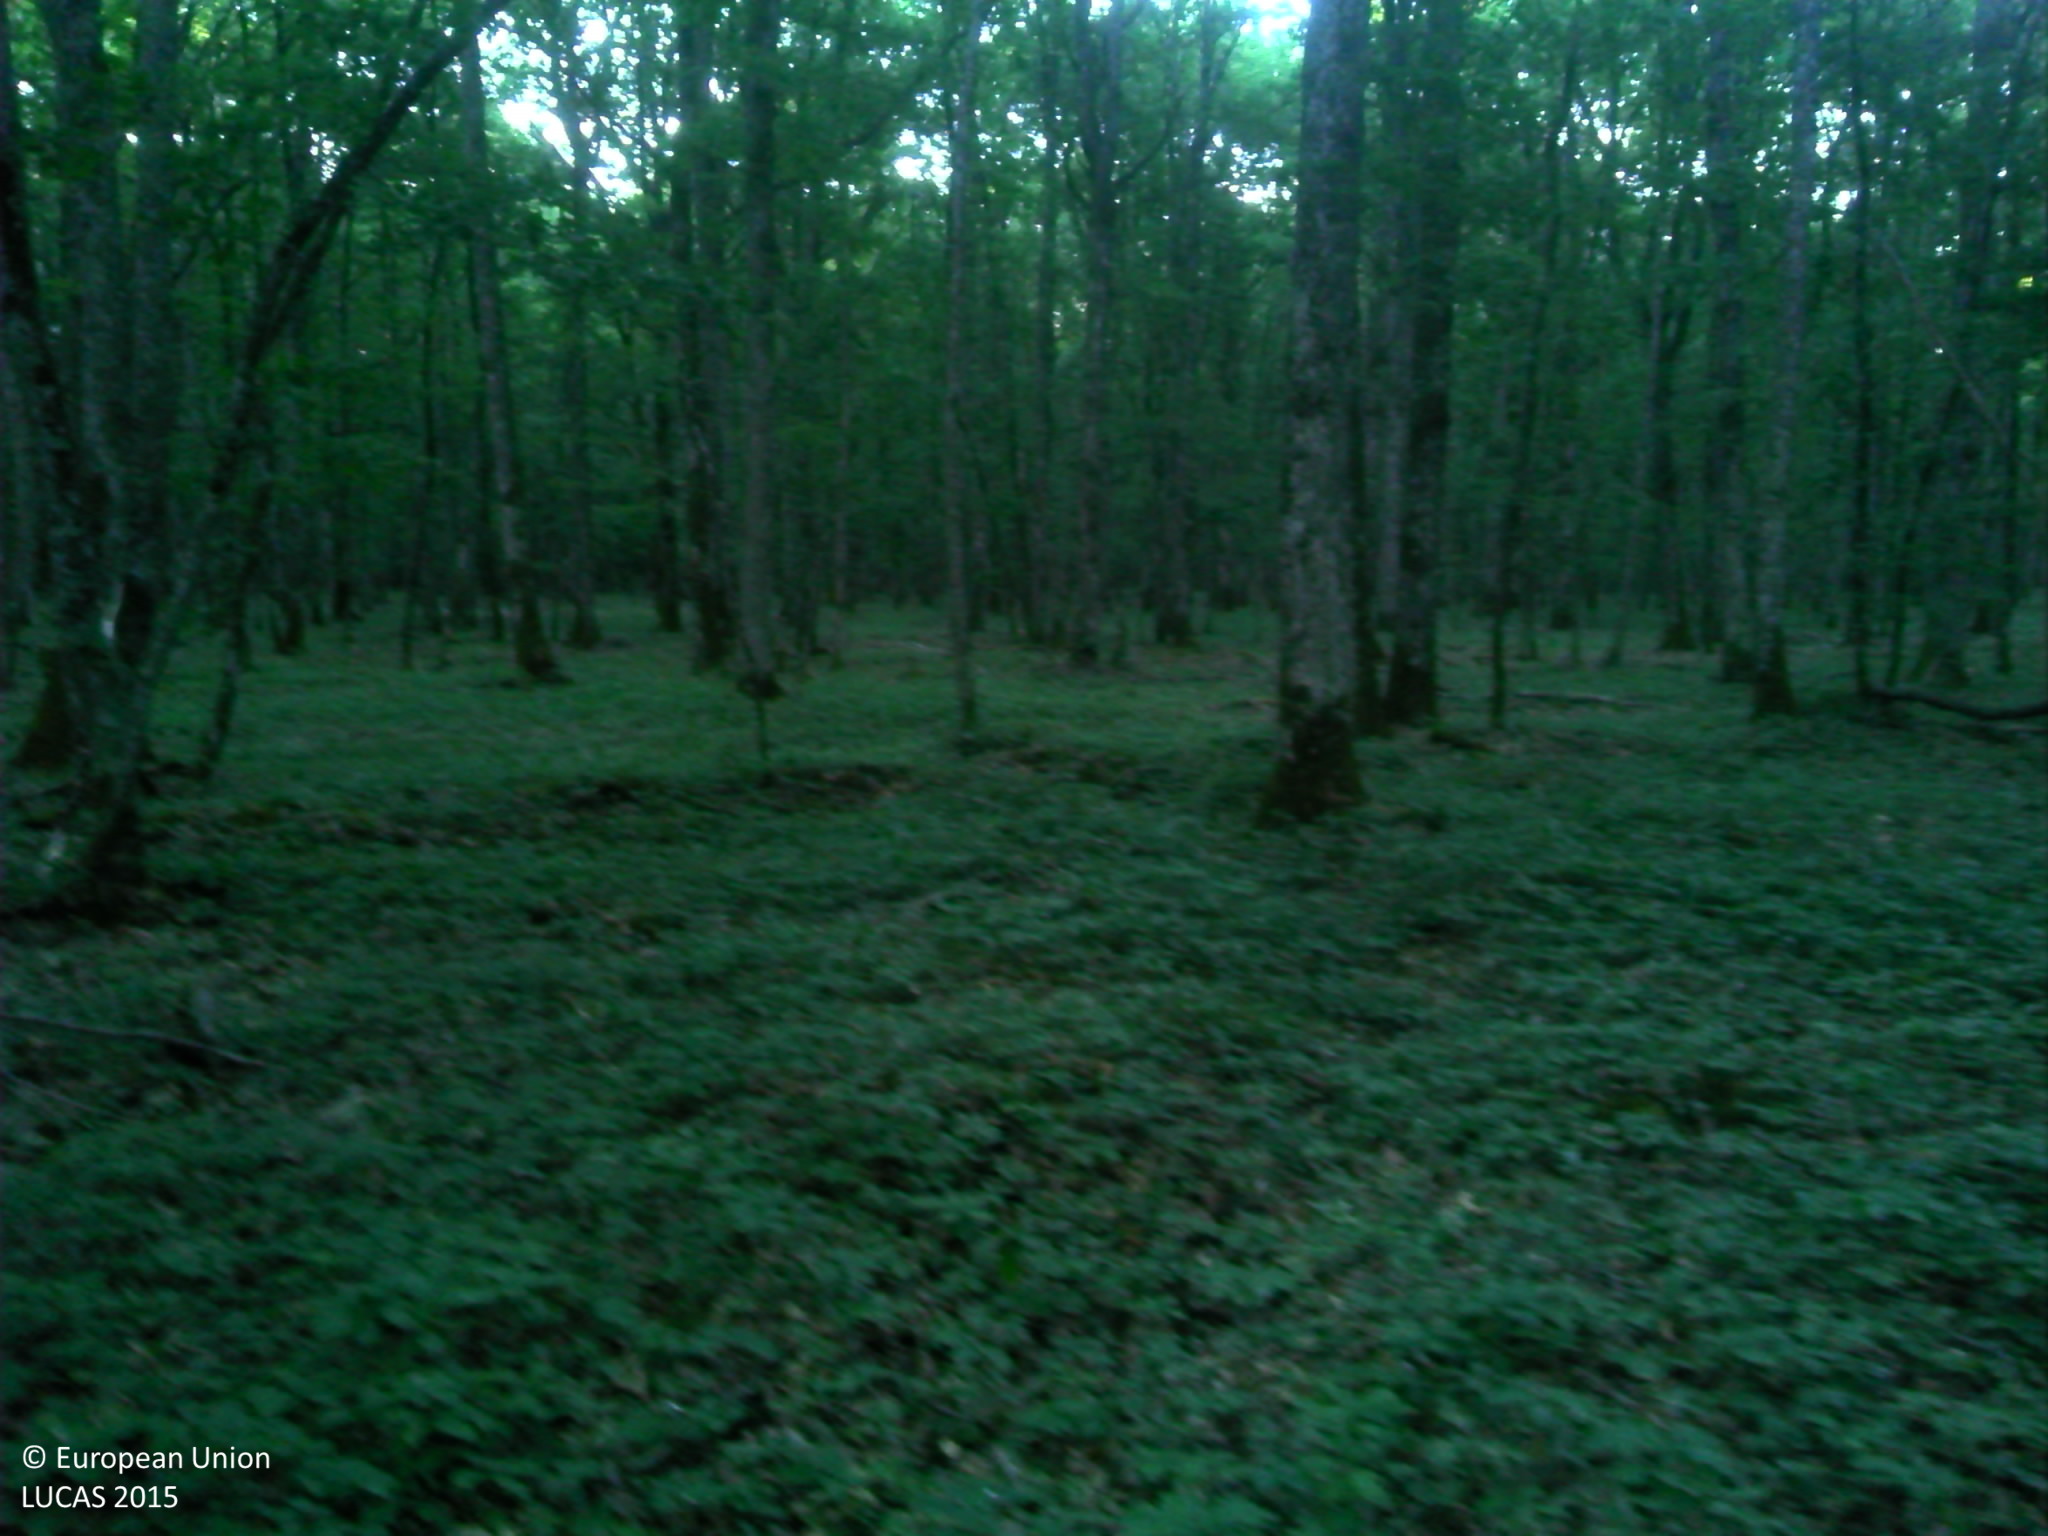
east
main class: Woodland
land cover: Broadleaved woodland
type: mesophytic deciduous forest
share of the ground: > 75 %
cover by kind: broadleaved forest trees 60 %, unconsolidated bare surface 40 %
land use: Forestry
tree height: > 5 m
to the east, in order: Broadleaved woodland; Tracks; Broadleaved woodland; Tracks; Broadleaved woodland
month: June
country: FR
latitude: 47.4518
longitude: 1.1640
